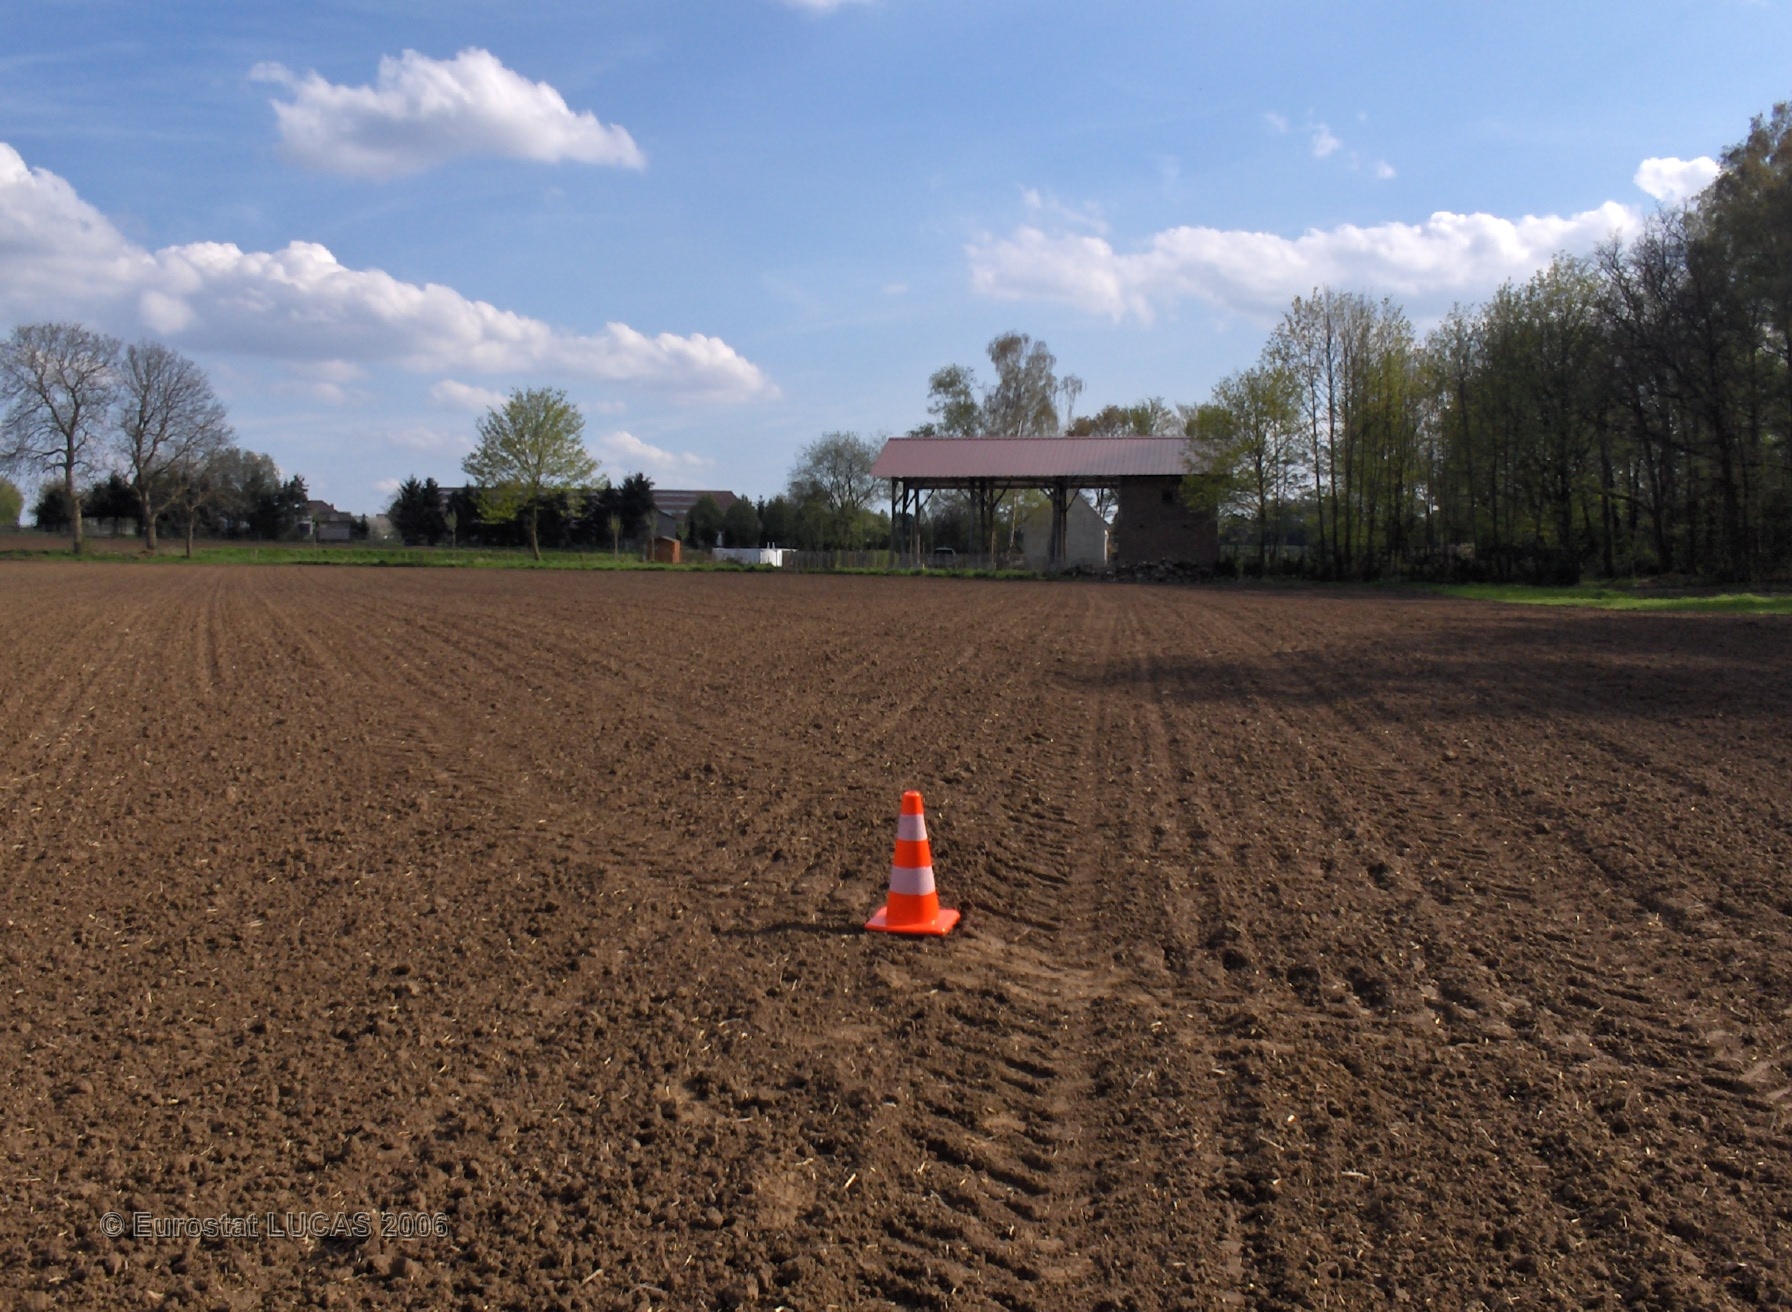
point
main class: Cropland
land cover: Sugar beet
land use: Agriculture (excluding fallow land and kitchen gardens)
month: May
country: BE
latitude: 50.7921
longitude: 4.5342
